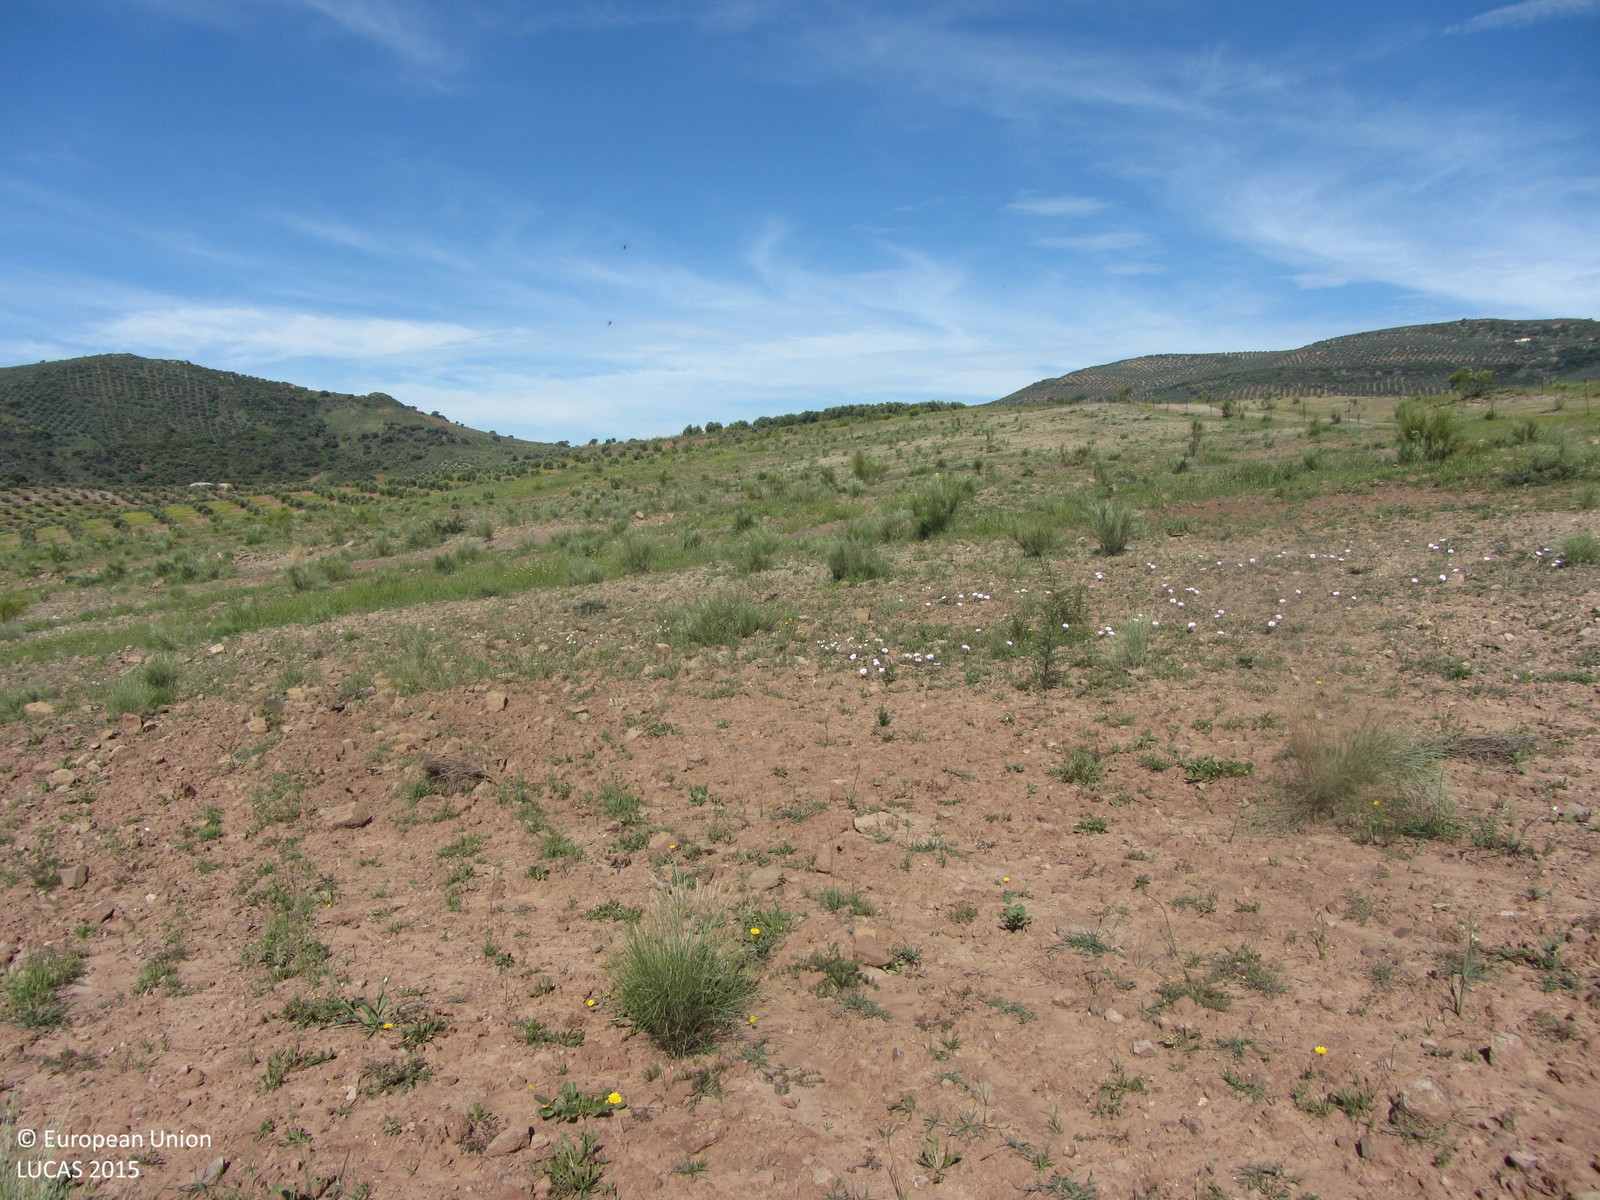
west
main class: Grassland
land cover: Spontaneously vegetated surfaces
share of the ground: 25 - 50 %
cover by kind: consolidated bare surface 65 %, herbaceous plants 35 %
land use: Semi-natural and natural areas not in use
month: May
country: ES
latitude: 38.2722
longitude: -3.0658
